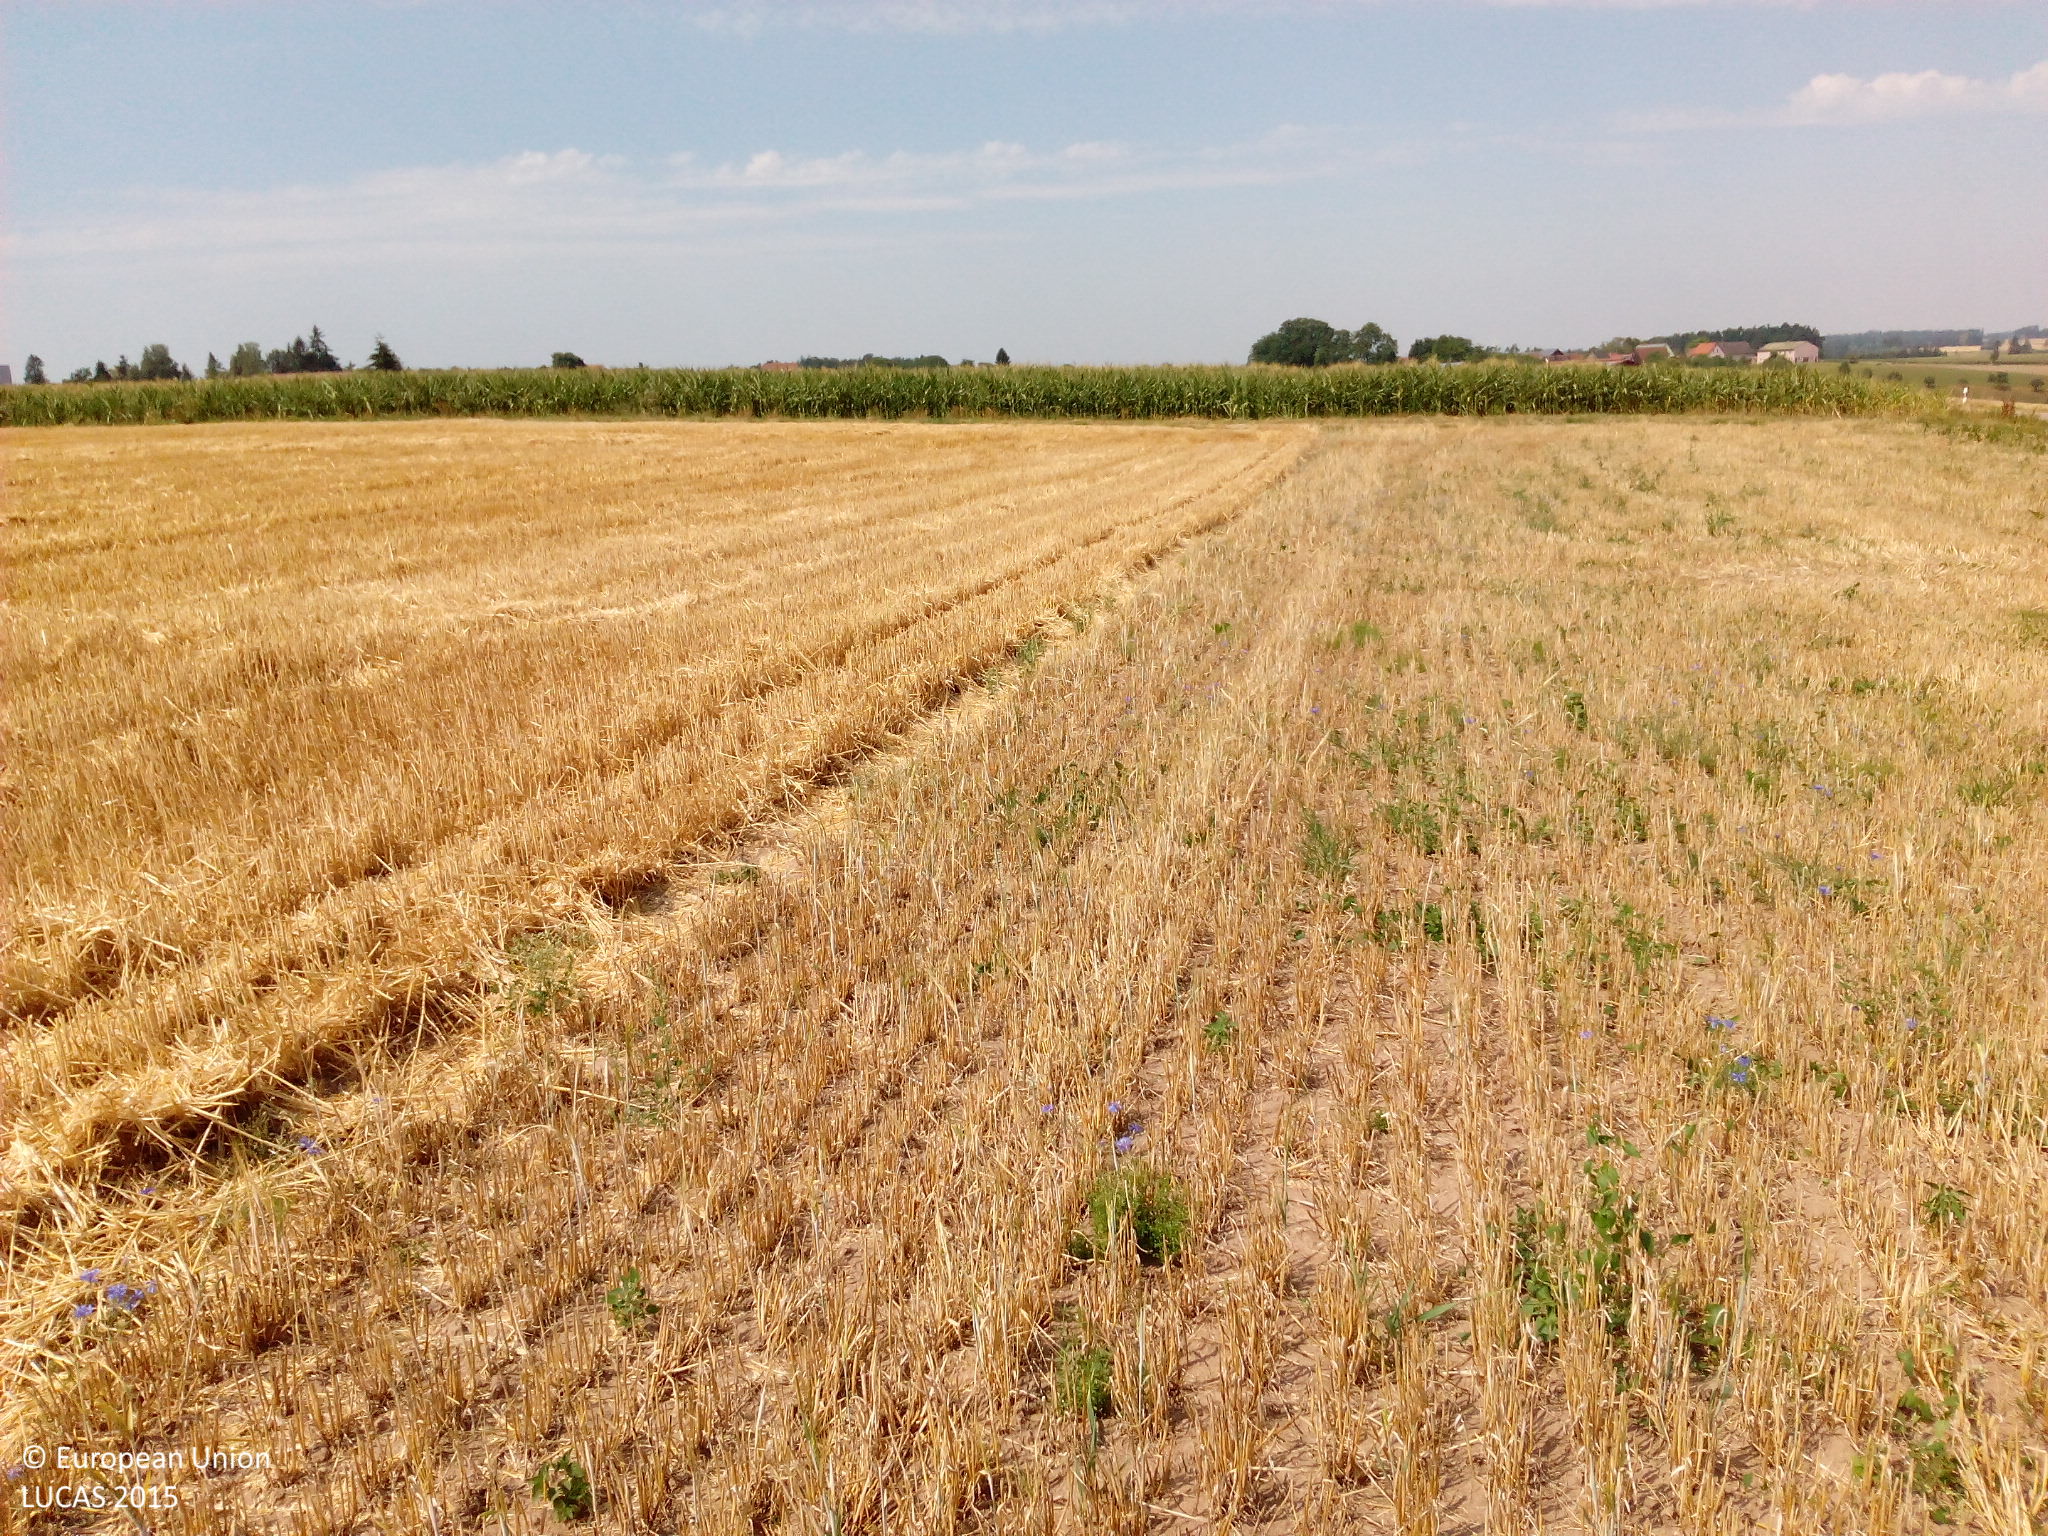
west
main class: Cropland
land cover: Barley
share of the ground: < 10 %
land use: Agriculture (excluding fallow land and kitchen gardens)
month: August
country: DE
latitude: 49.1048
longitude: 10.2601
